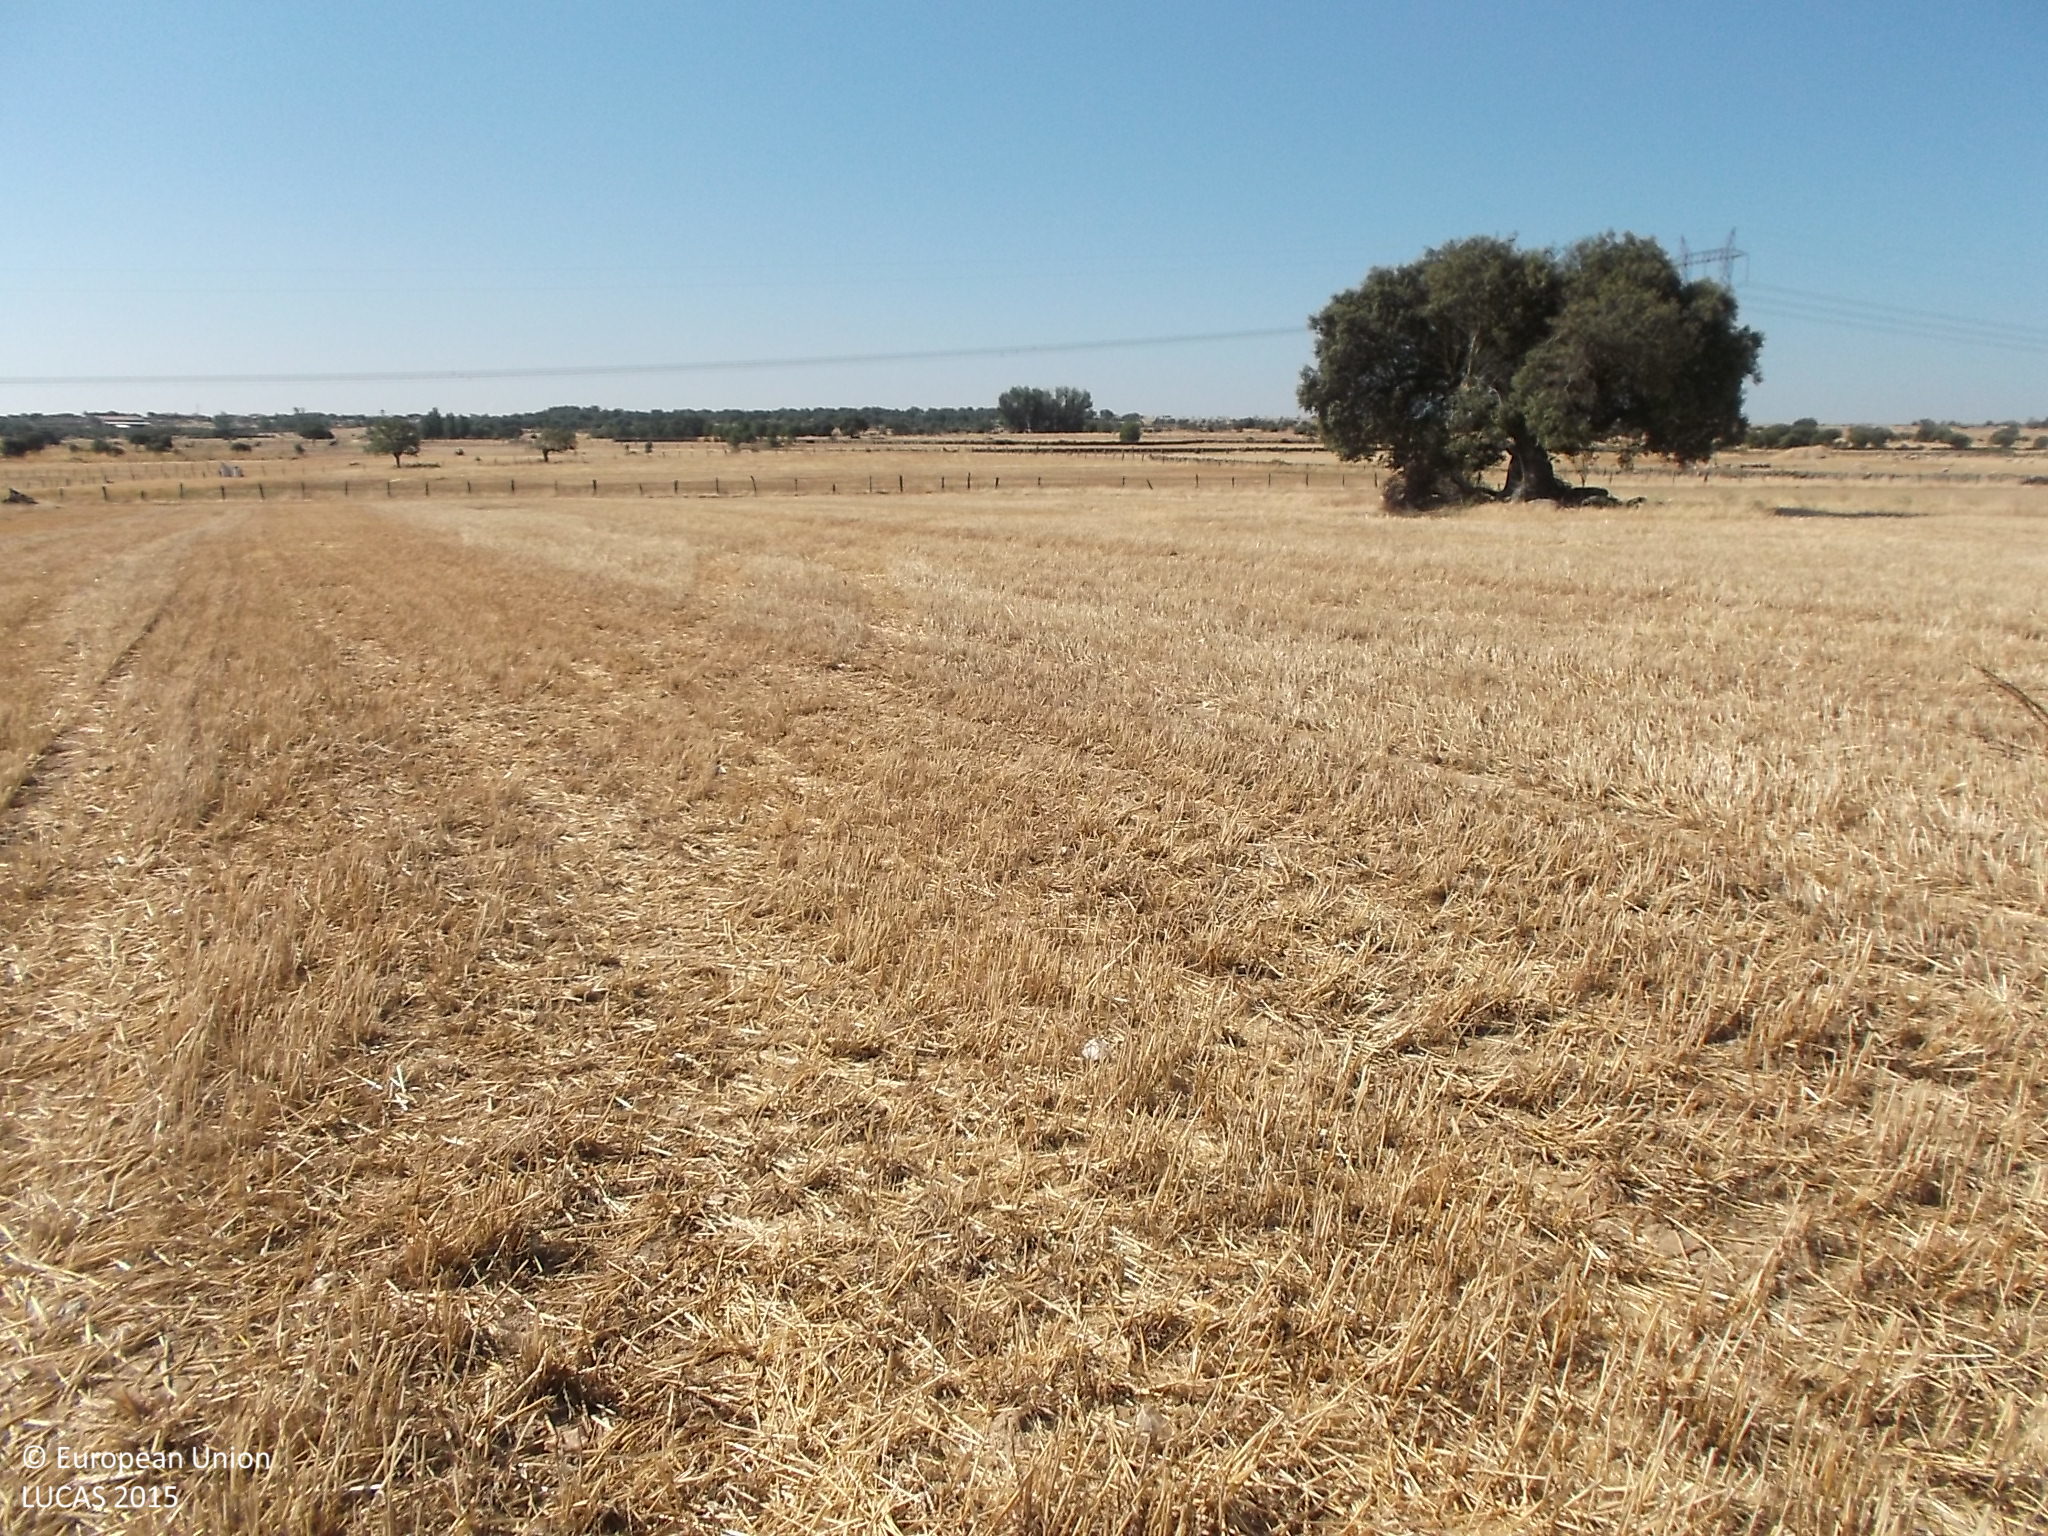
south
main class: Cropland
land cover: Barley
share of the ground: < 10 %
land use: Agriculture (excluding fallow land and kitchen gardens)
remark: Harvested field
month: July
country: ES
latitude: 41.3681
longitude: -6.0267
